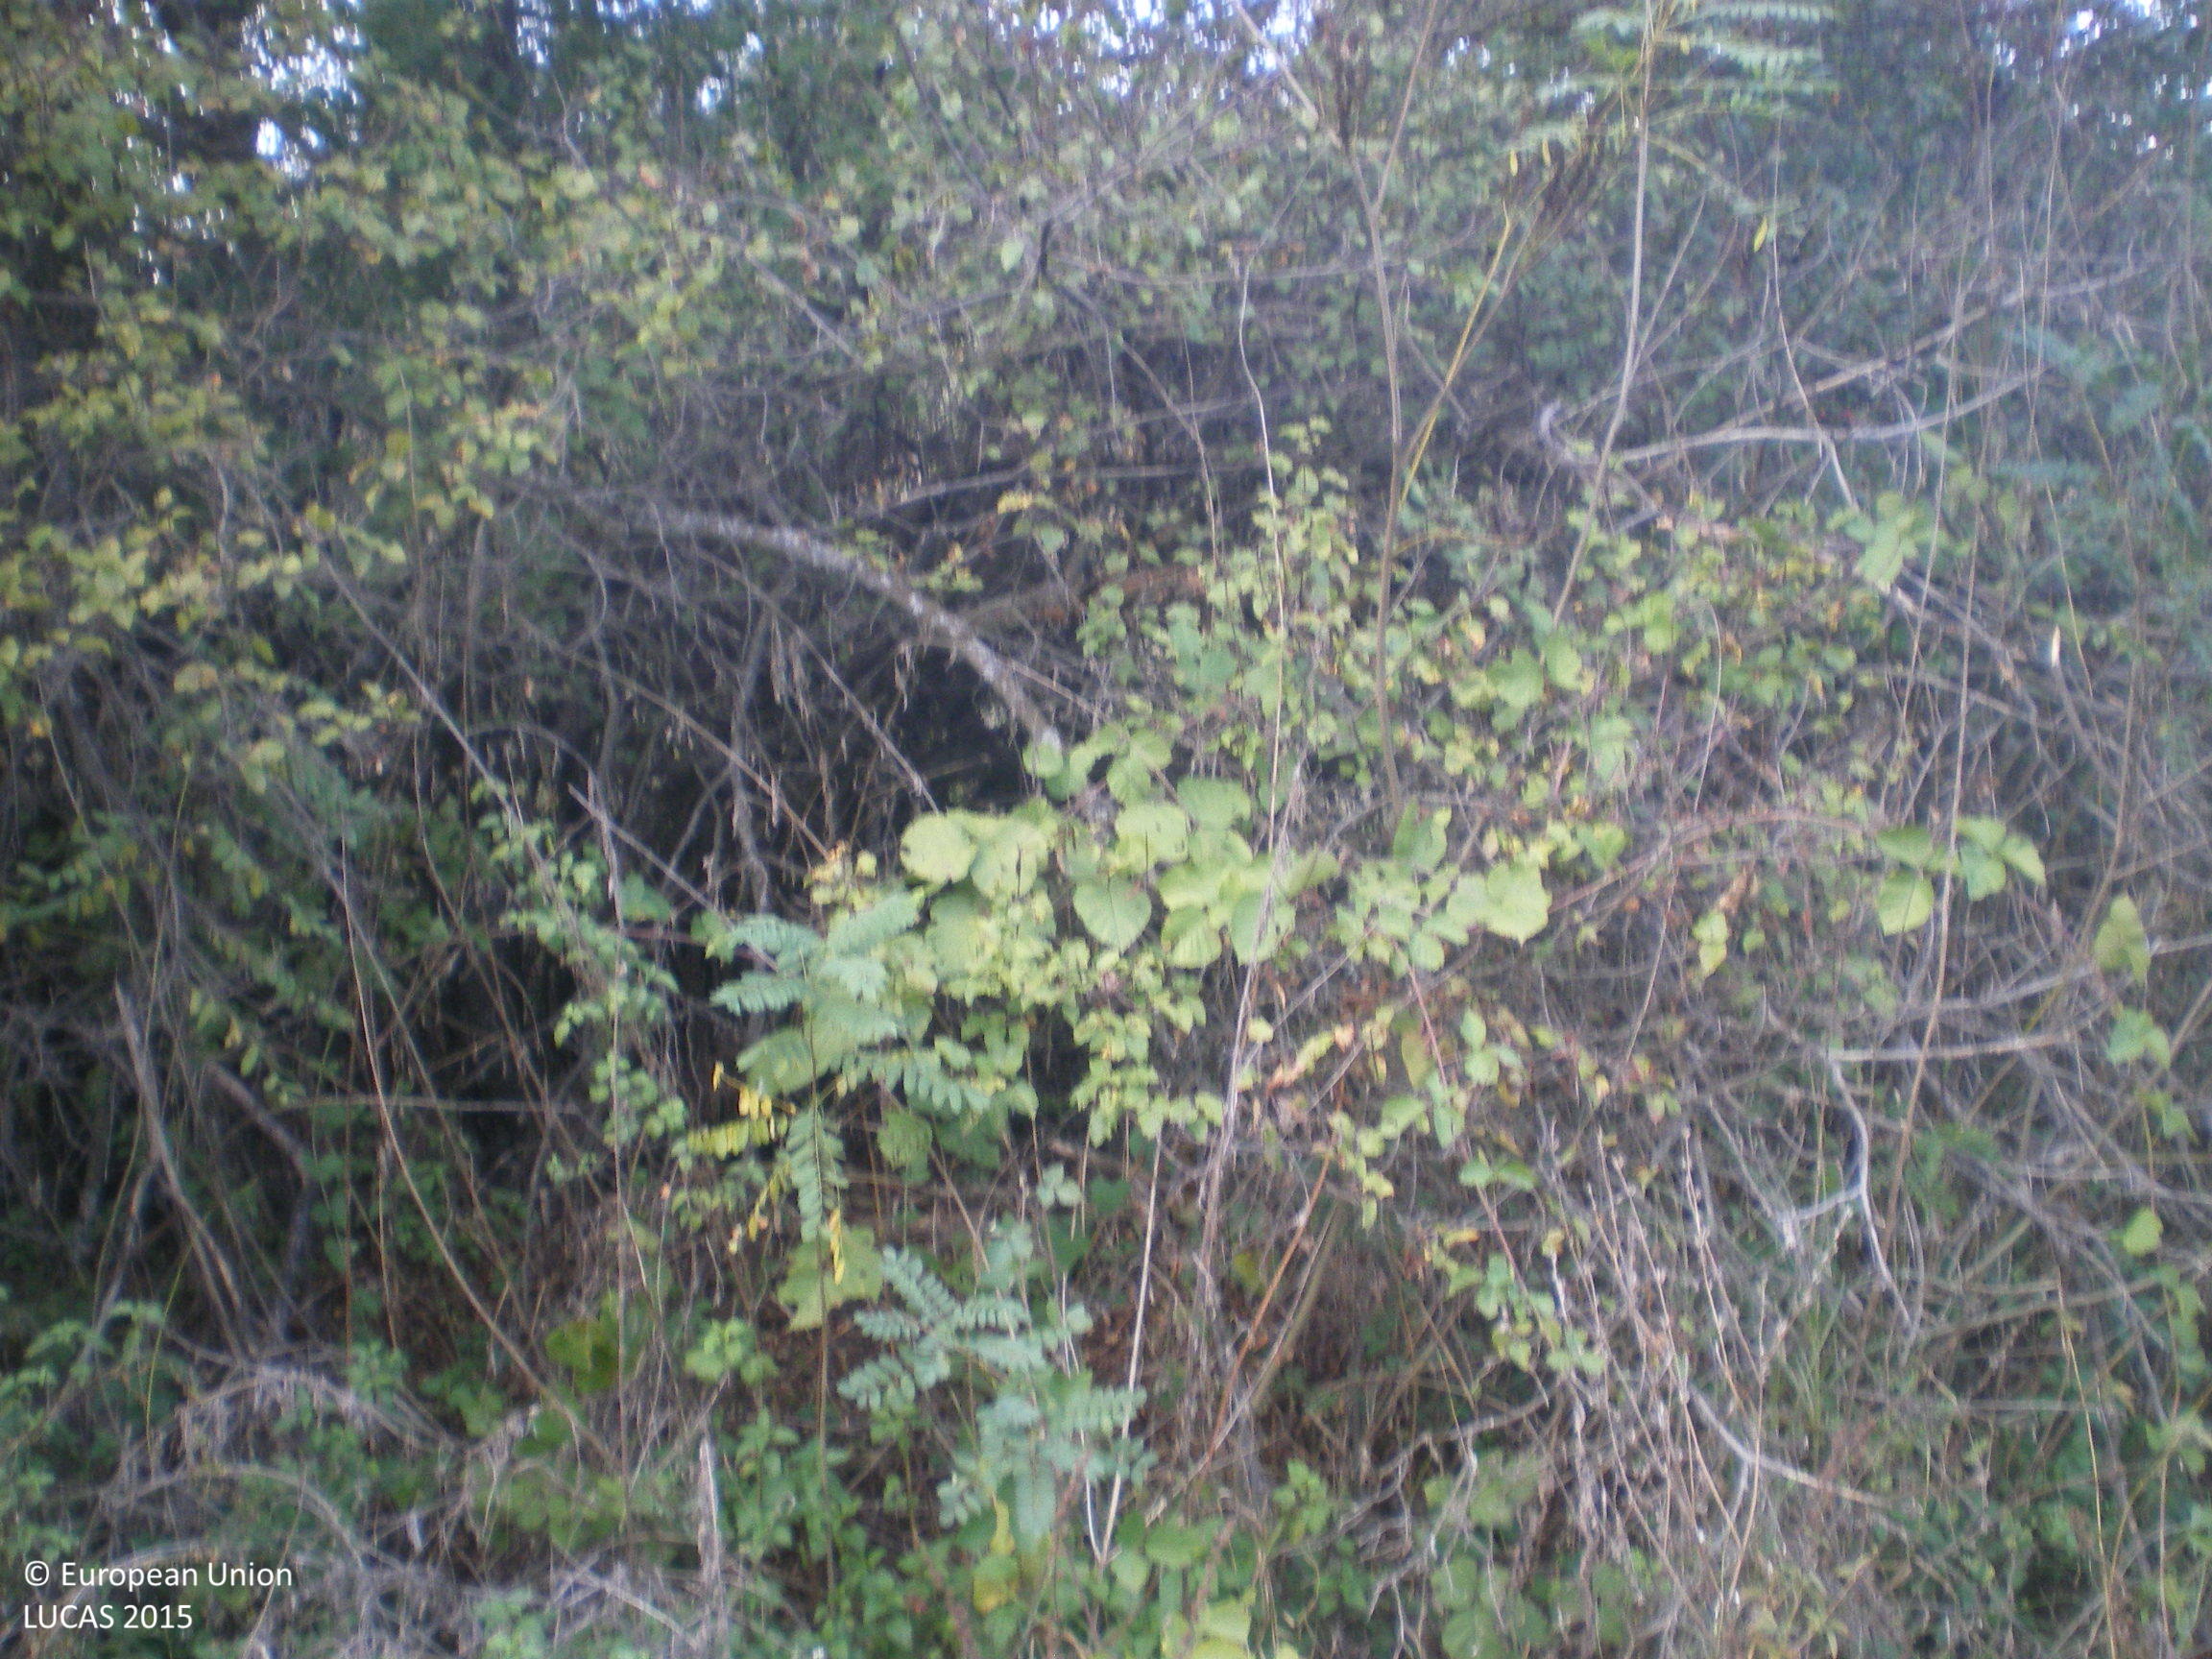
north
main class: Grassland
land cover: Grassland with sparse tree/shrub cover
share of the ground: > 75 %
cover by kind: herbaceous plants 90 %, broadleaved forest trees 5 %, shrubs 5 %
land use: Agriculture (excluding fallow land and kitchen gardens)
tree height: > 5 m
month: October
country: BG
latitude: 42.0901
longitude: 26.2205
